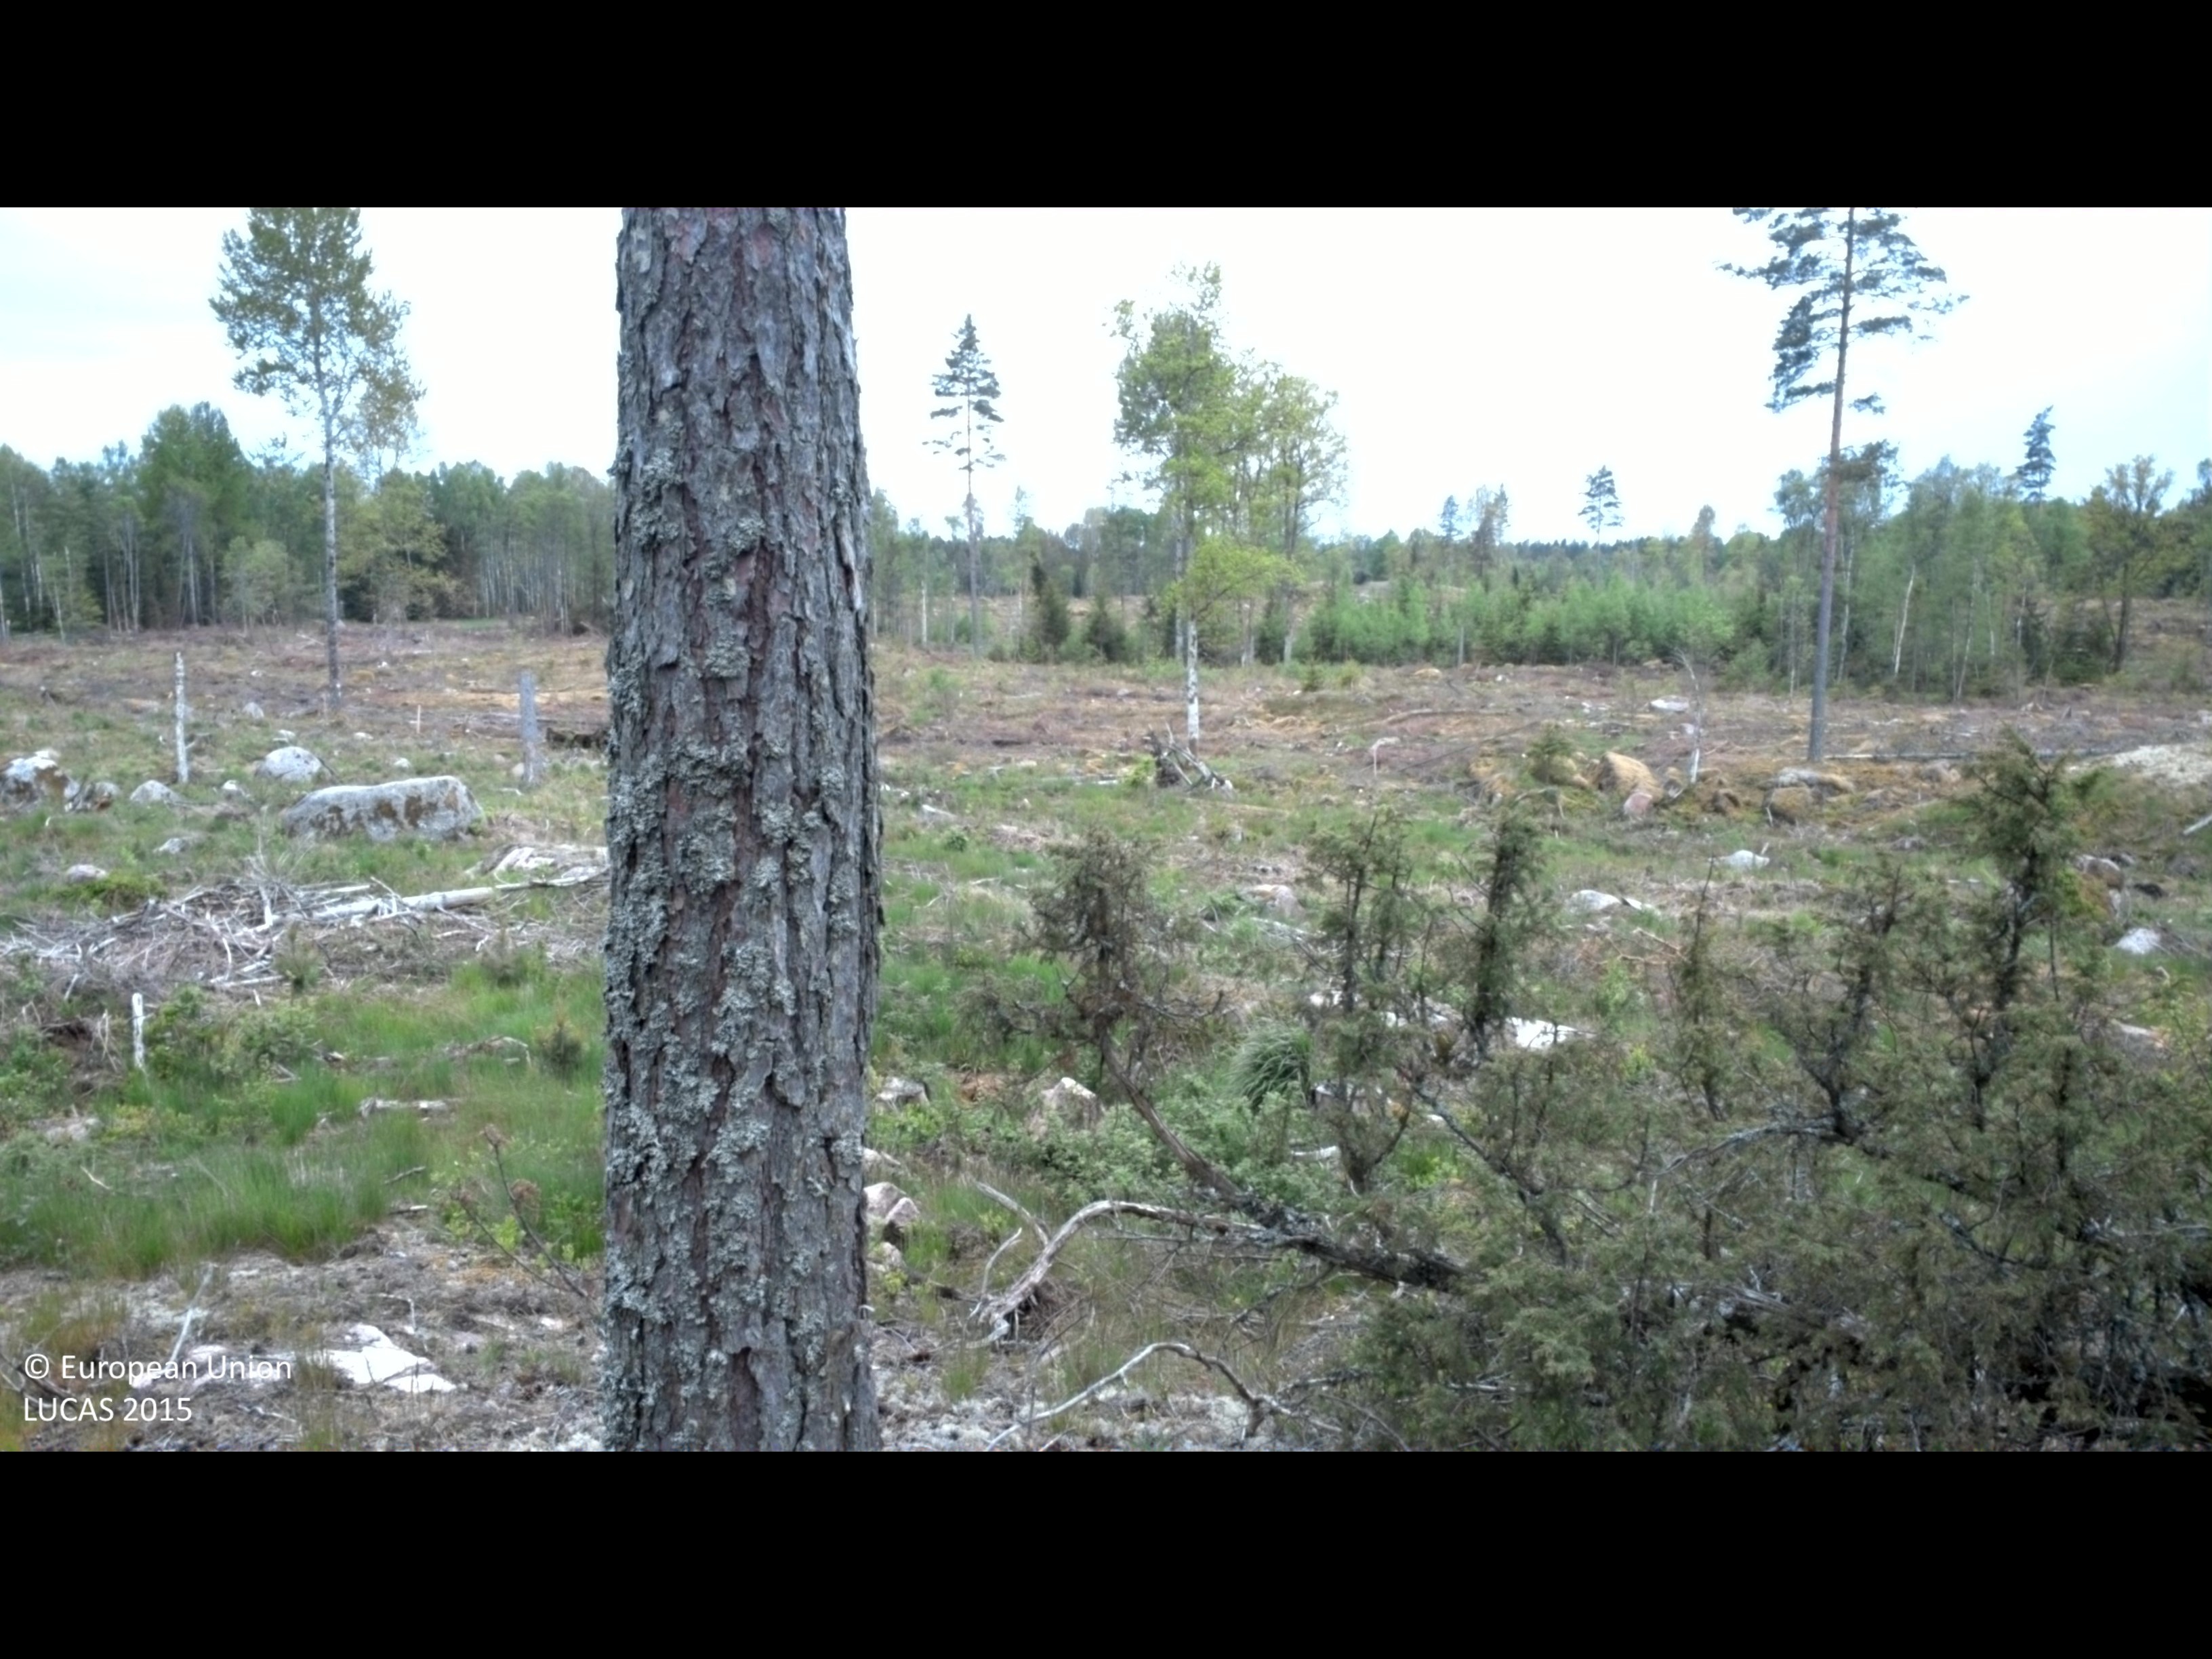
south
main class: Woodland
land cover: Pine dominated coniferous woodland
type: boreal forest
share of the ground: 10 - 25 %
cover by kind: lichens and mosses 45 %, shrubs 35 %, coniferous forest trees 15 %, broadleaved forest trees 5 %
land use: Forestry
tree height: > 5 m
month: May
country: SE
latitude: 57.4801
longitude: 16.2194
